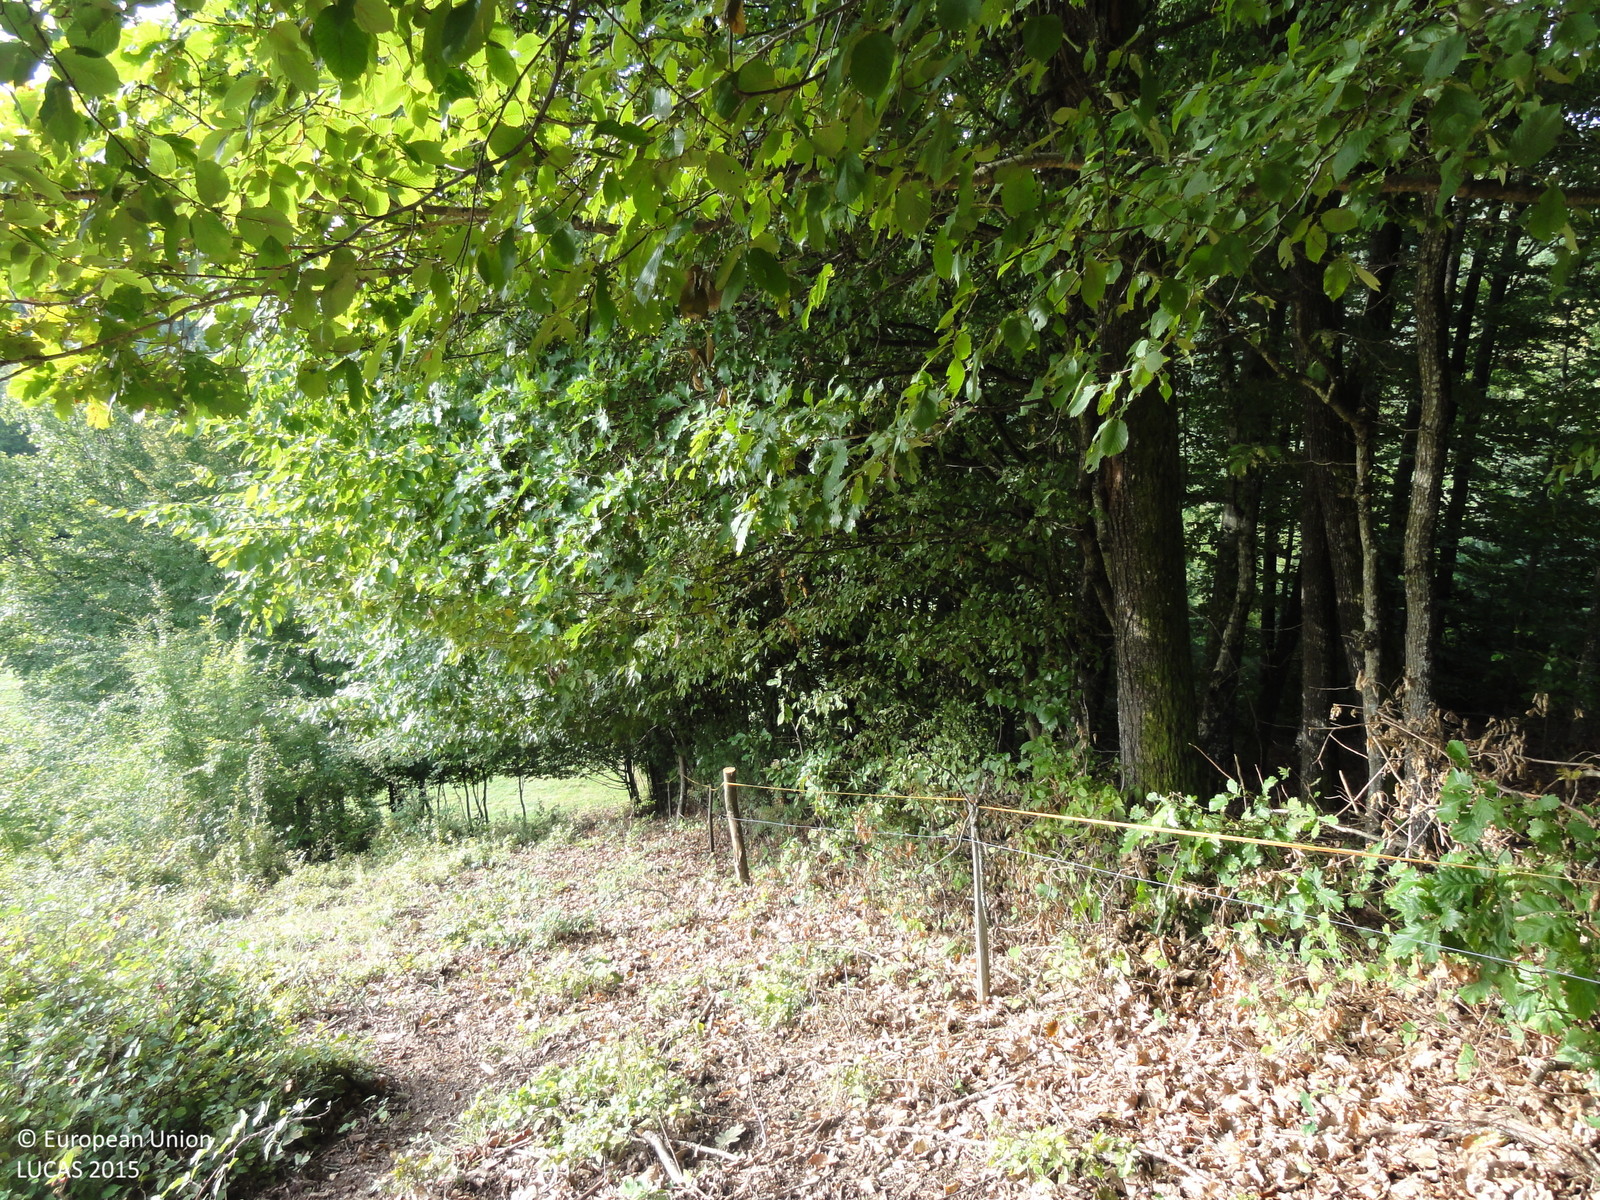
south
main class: Shrubland
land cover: Shrubland with sparse tree cover
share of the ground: 50 - 75 %
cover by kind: shrubs 45 %, herbaceous plants 30 %, broadleaved forest trees 5 %
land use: Agriculture (excluding fallow land and kitchen gardens)
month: September
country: SI
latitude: 45.8408
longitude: 15.6497
